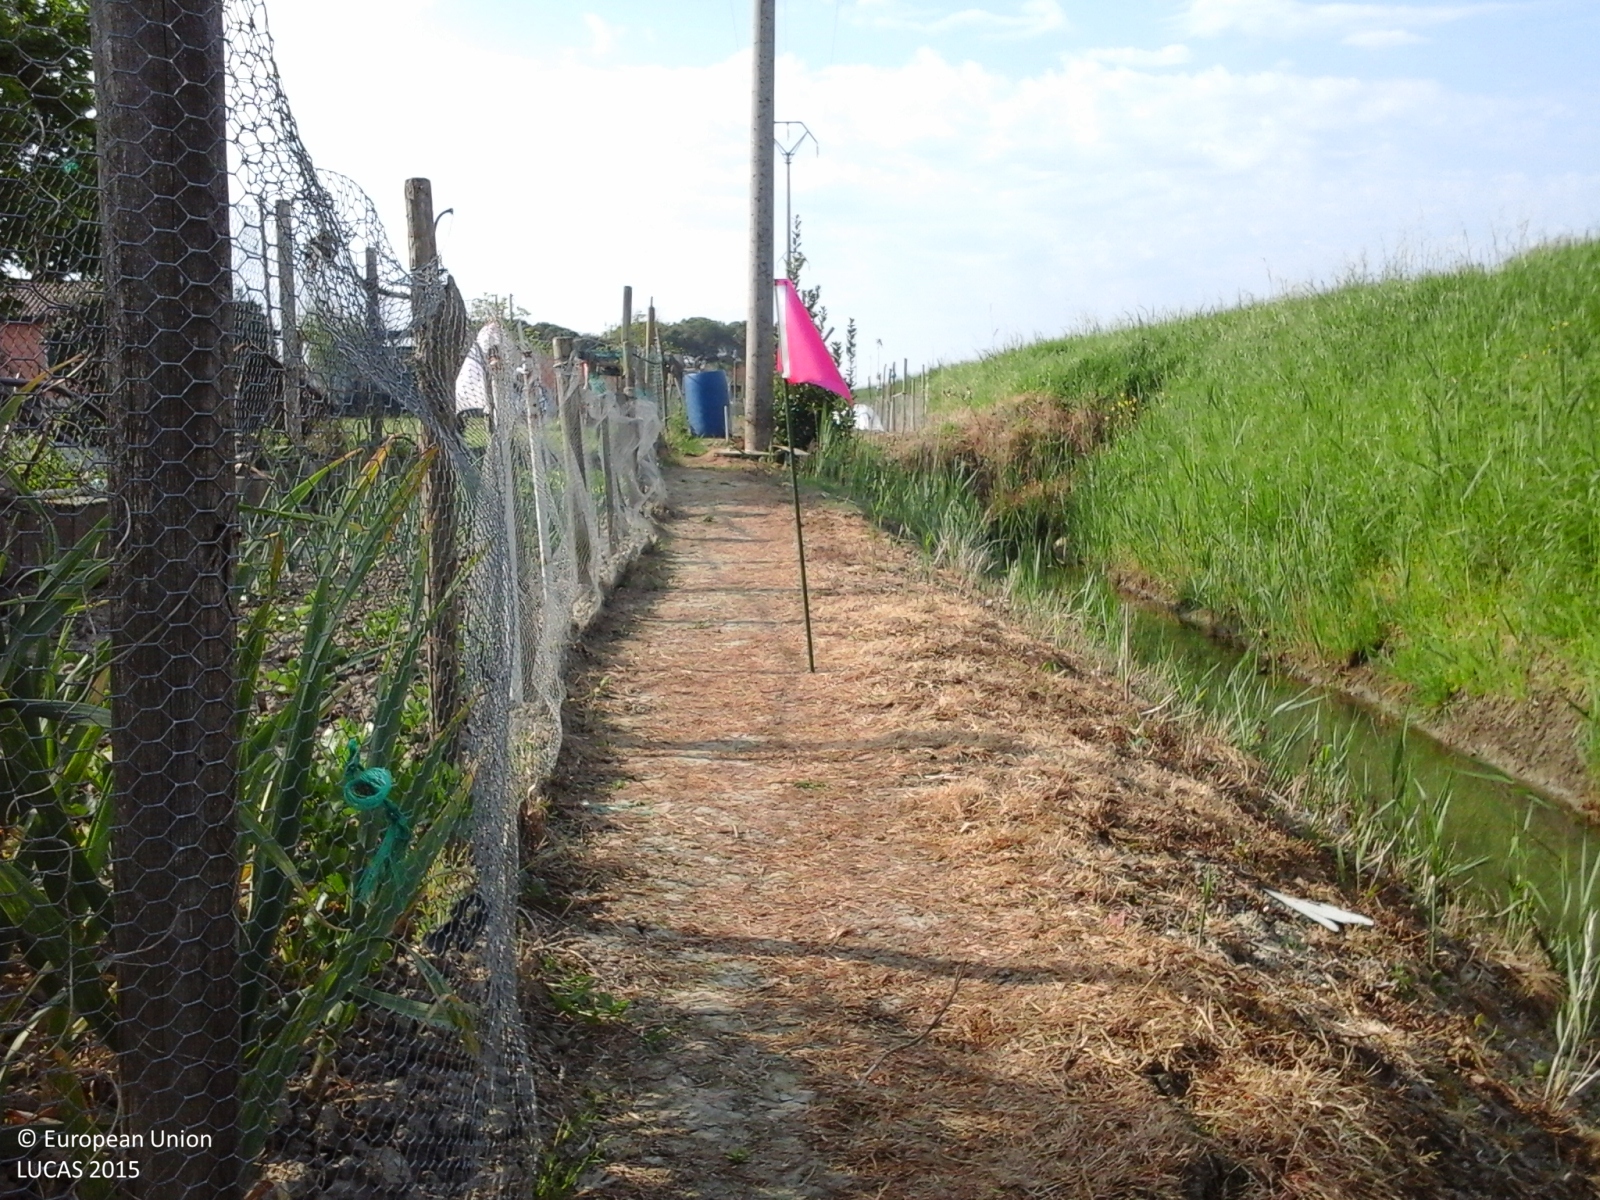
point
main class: Cropland
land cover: Other fresh vegetables
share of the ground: < 10 %
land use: Kitchen garden
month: April
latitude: 44.8625
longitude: 12.4633
